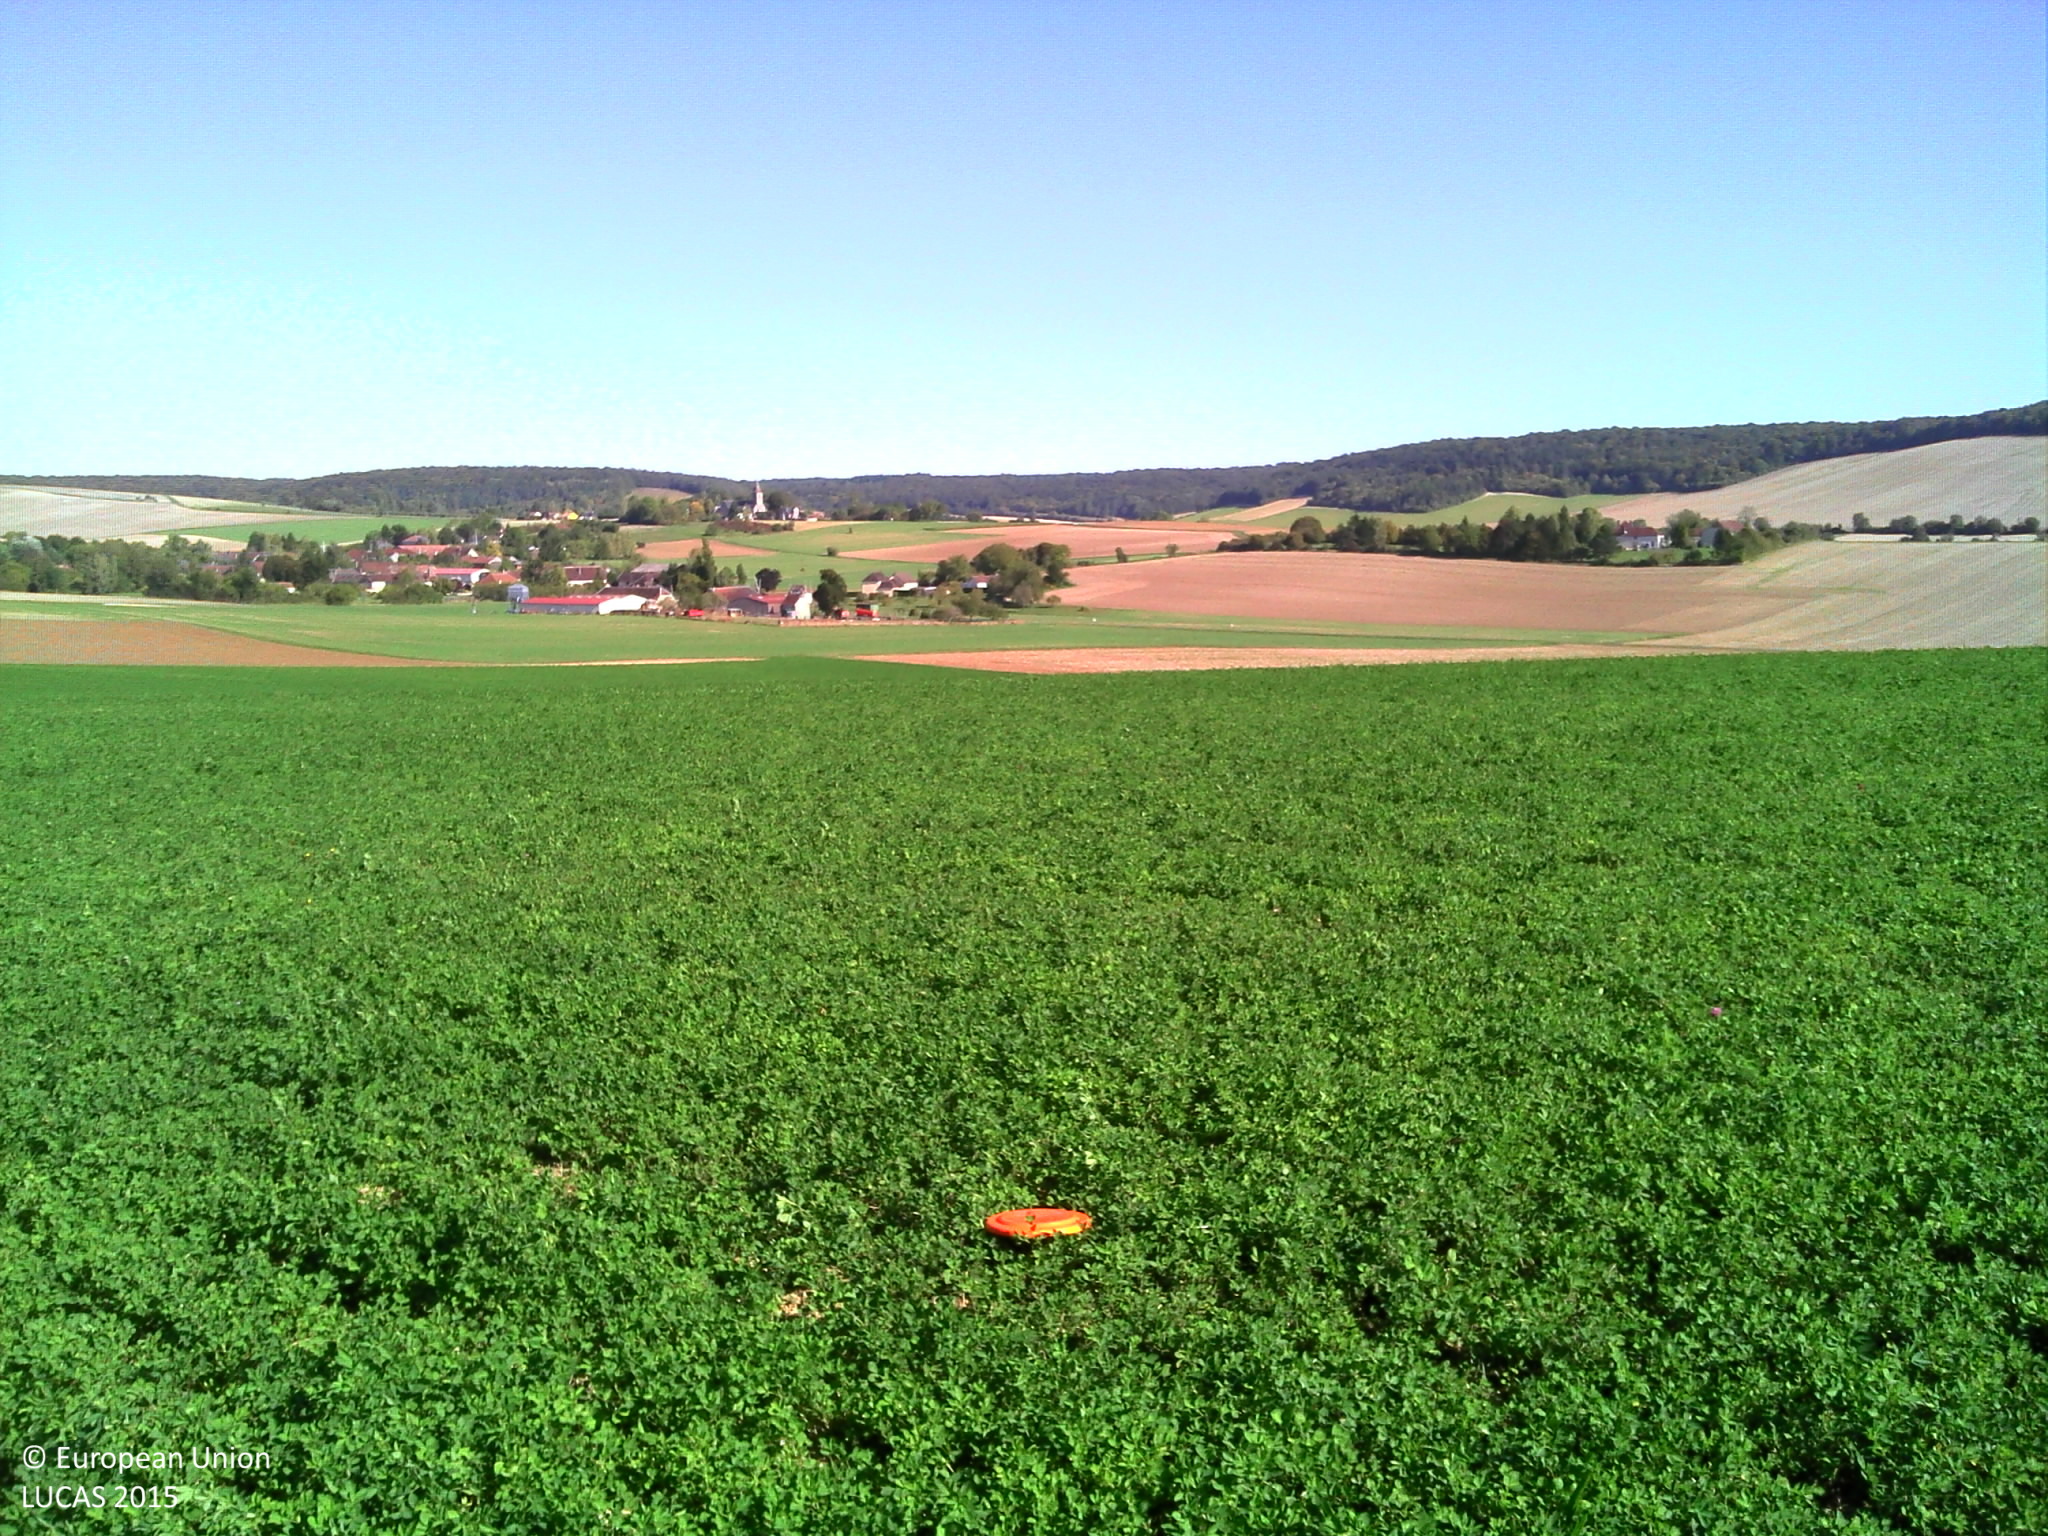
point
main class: Cropland
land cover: Lucerne
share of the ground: > 75 %
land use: Agriculture (excluding fallow land and kitchen gardens)
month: September
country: FR
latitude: 48.1079
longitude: 3.8852
